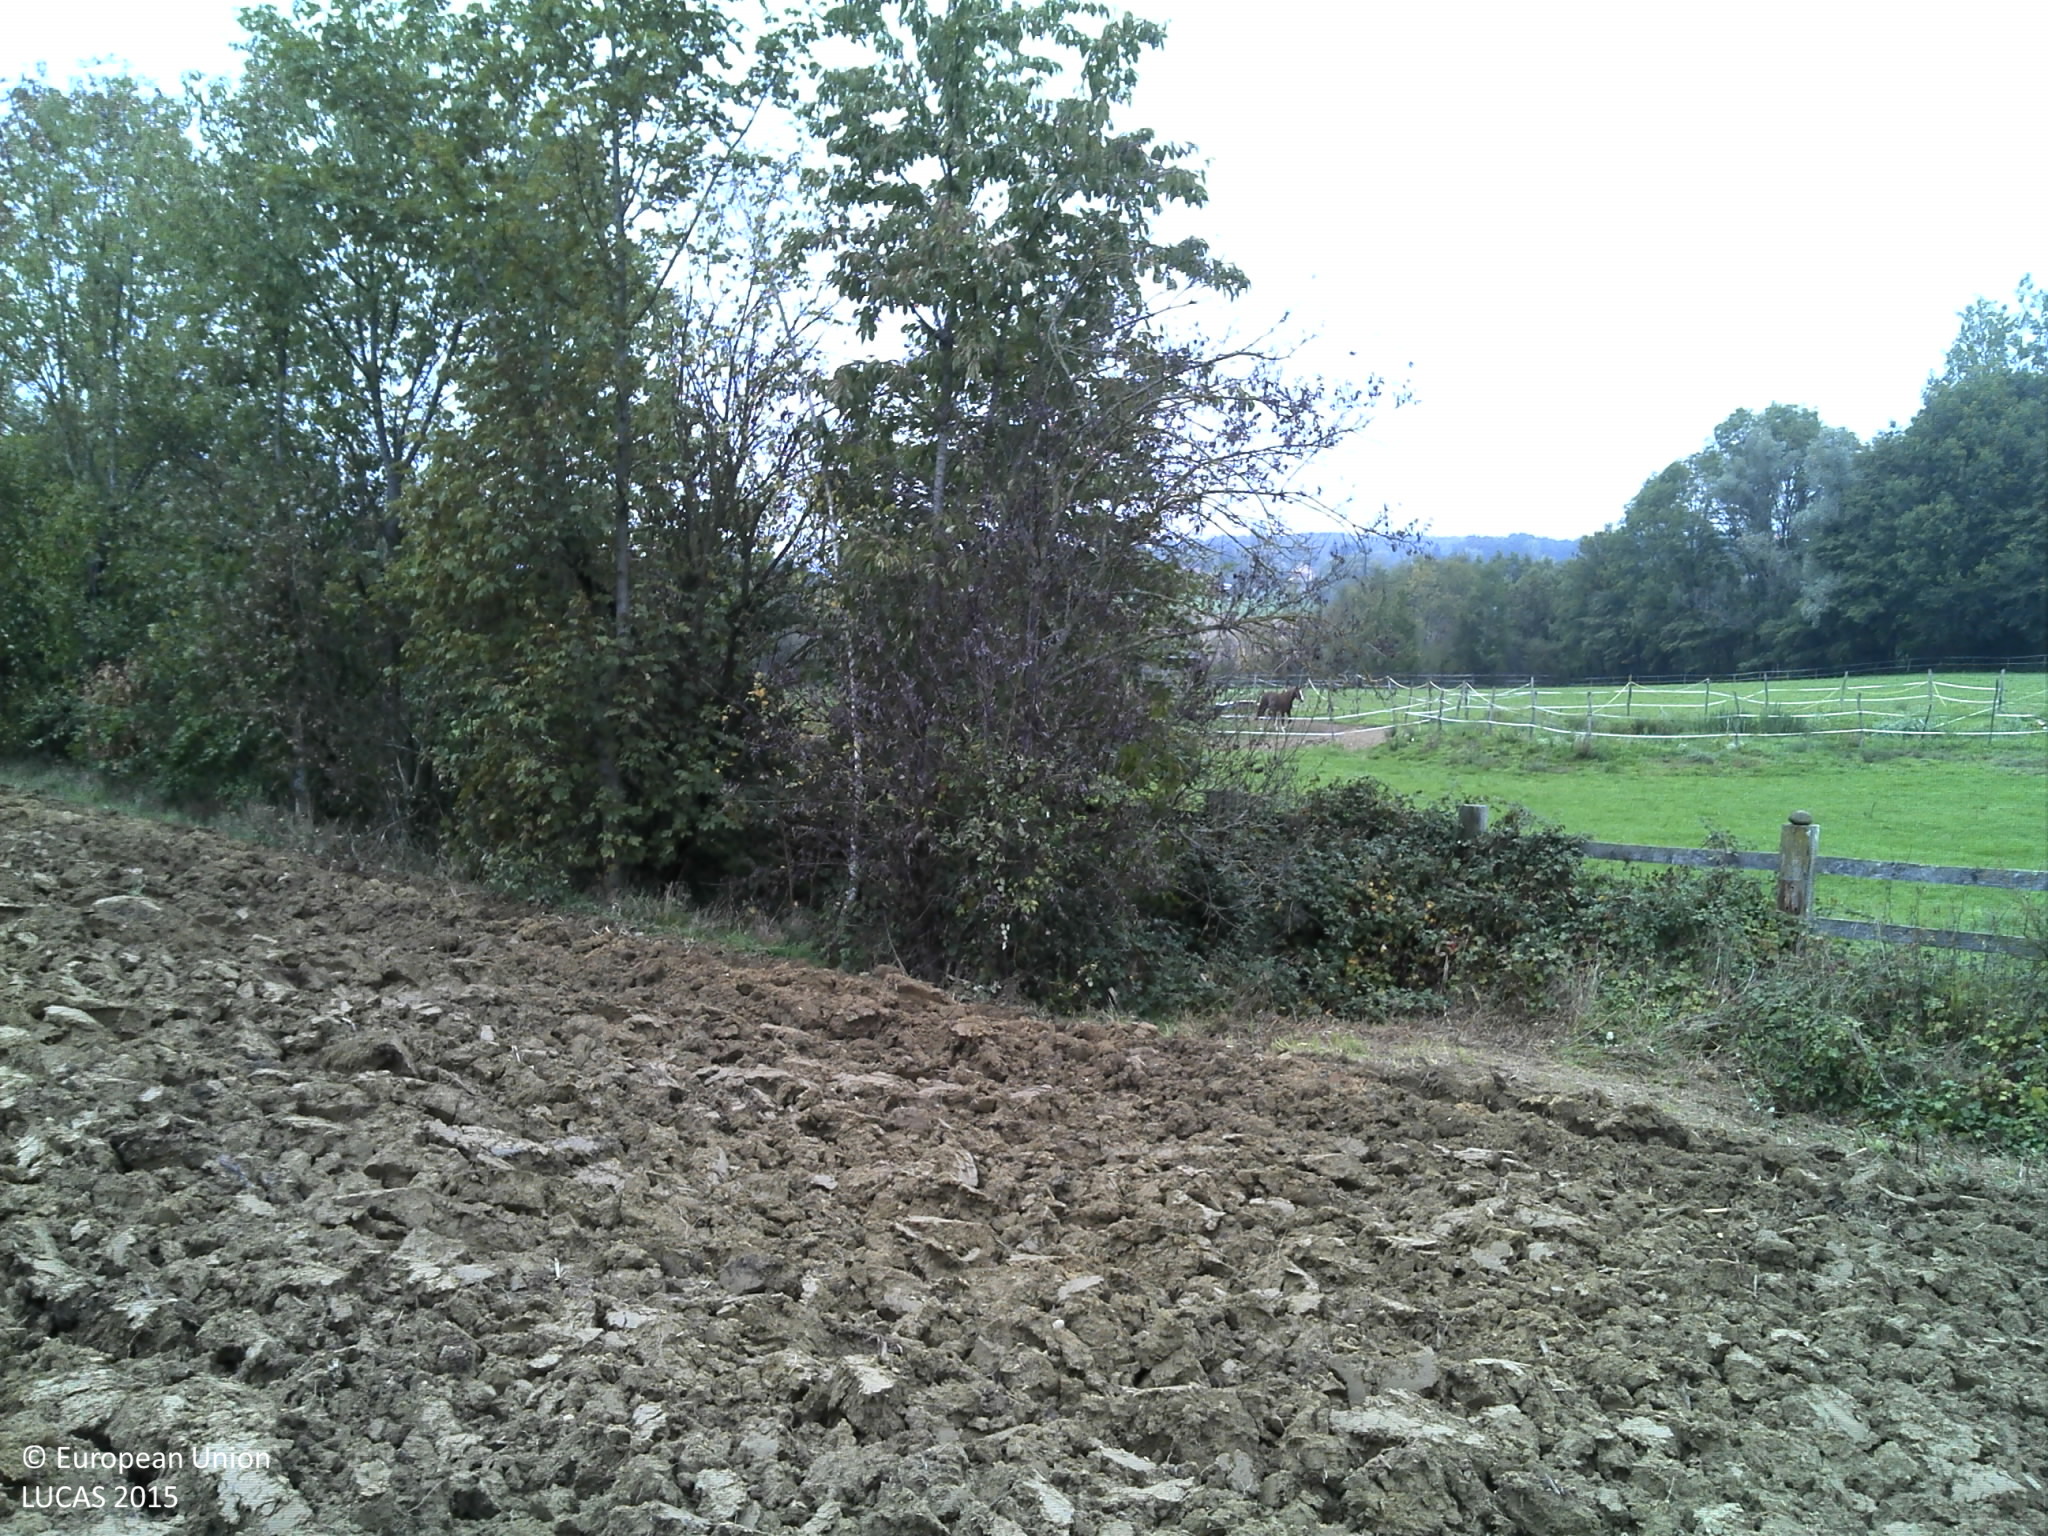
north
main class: Cropland
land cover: Maize
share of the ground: < 10 %
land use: Agriculture (excluding fallow land and kitchen gardens)
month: October
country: FR
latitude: 46.3398
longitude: 5.3386
